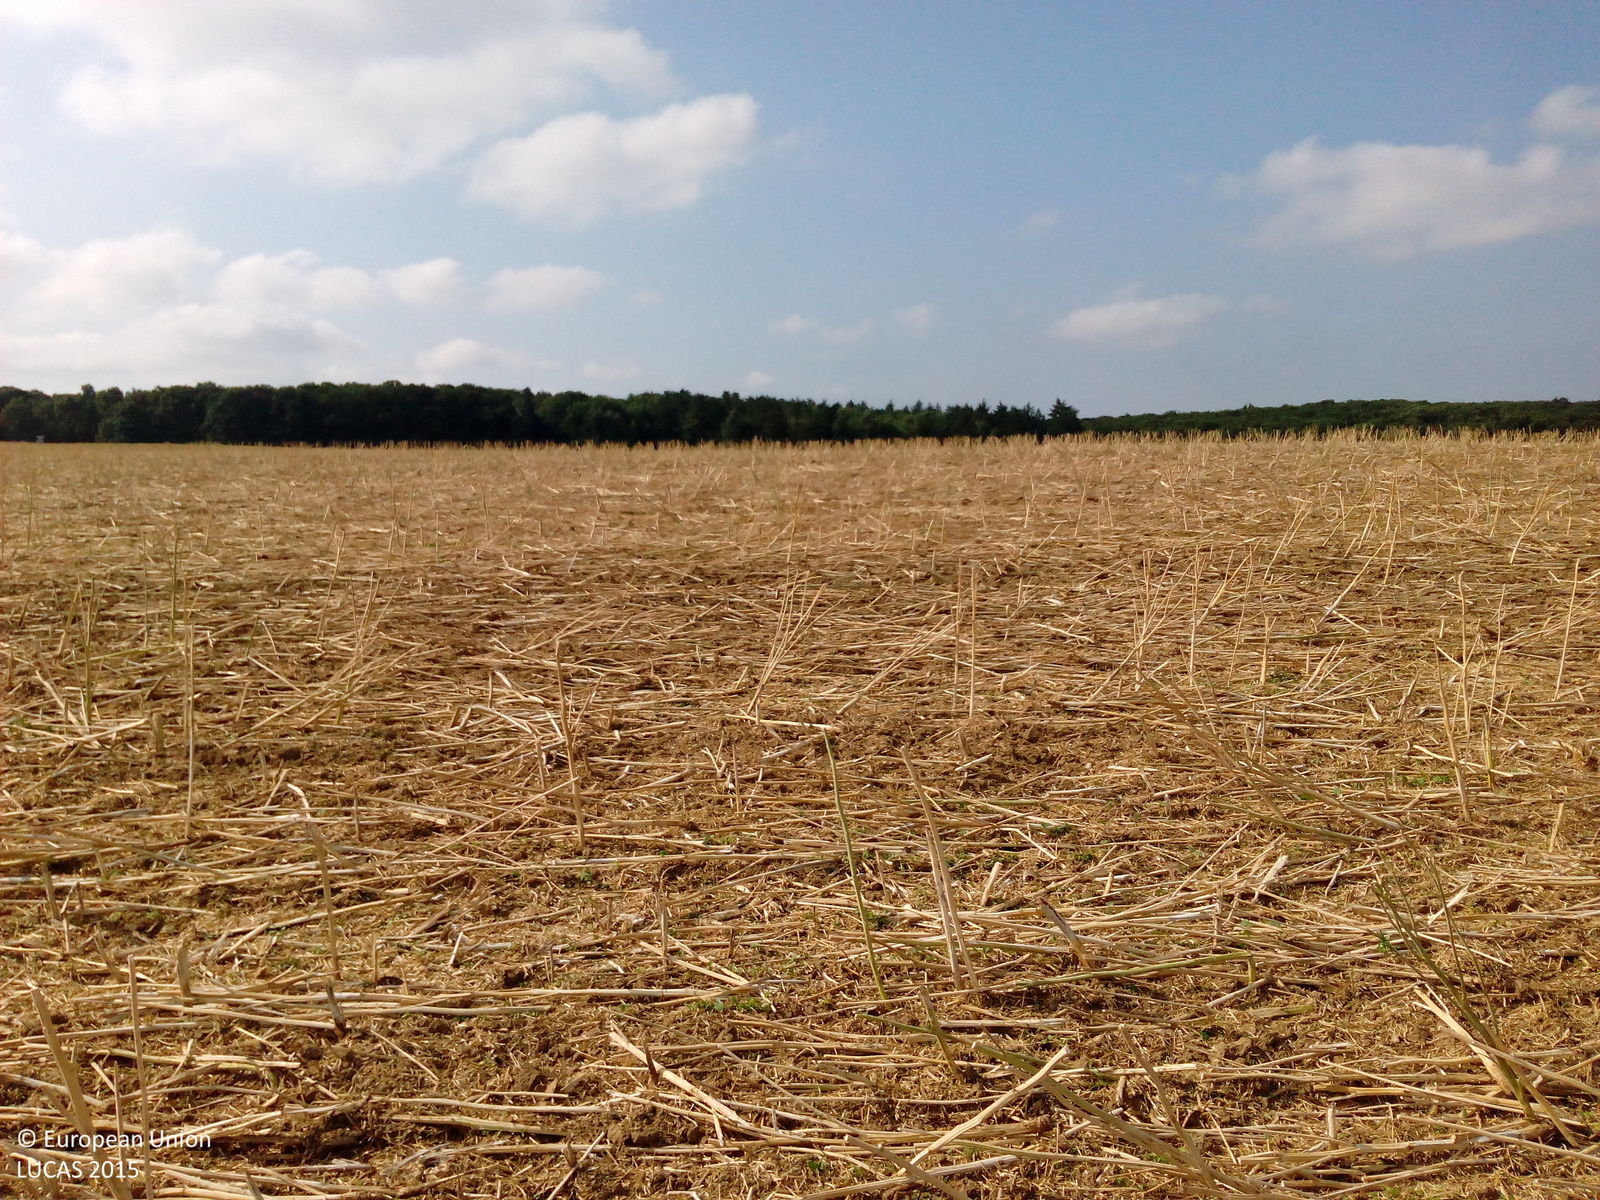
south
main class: Cropland
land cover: Rape and turnip rape
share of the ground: 10 - 25 %
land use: Agriculture (excluding fallow land and kitchen gardens)
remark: Harvested field
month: August
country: DE
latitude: 51.8342
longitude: 10.9720
